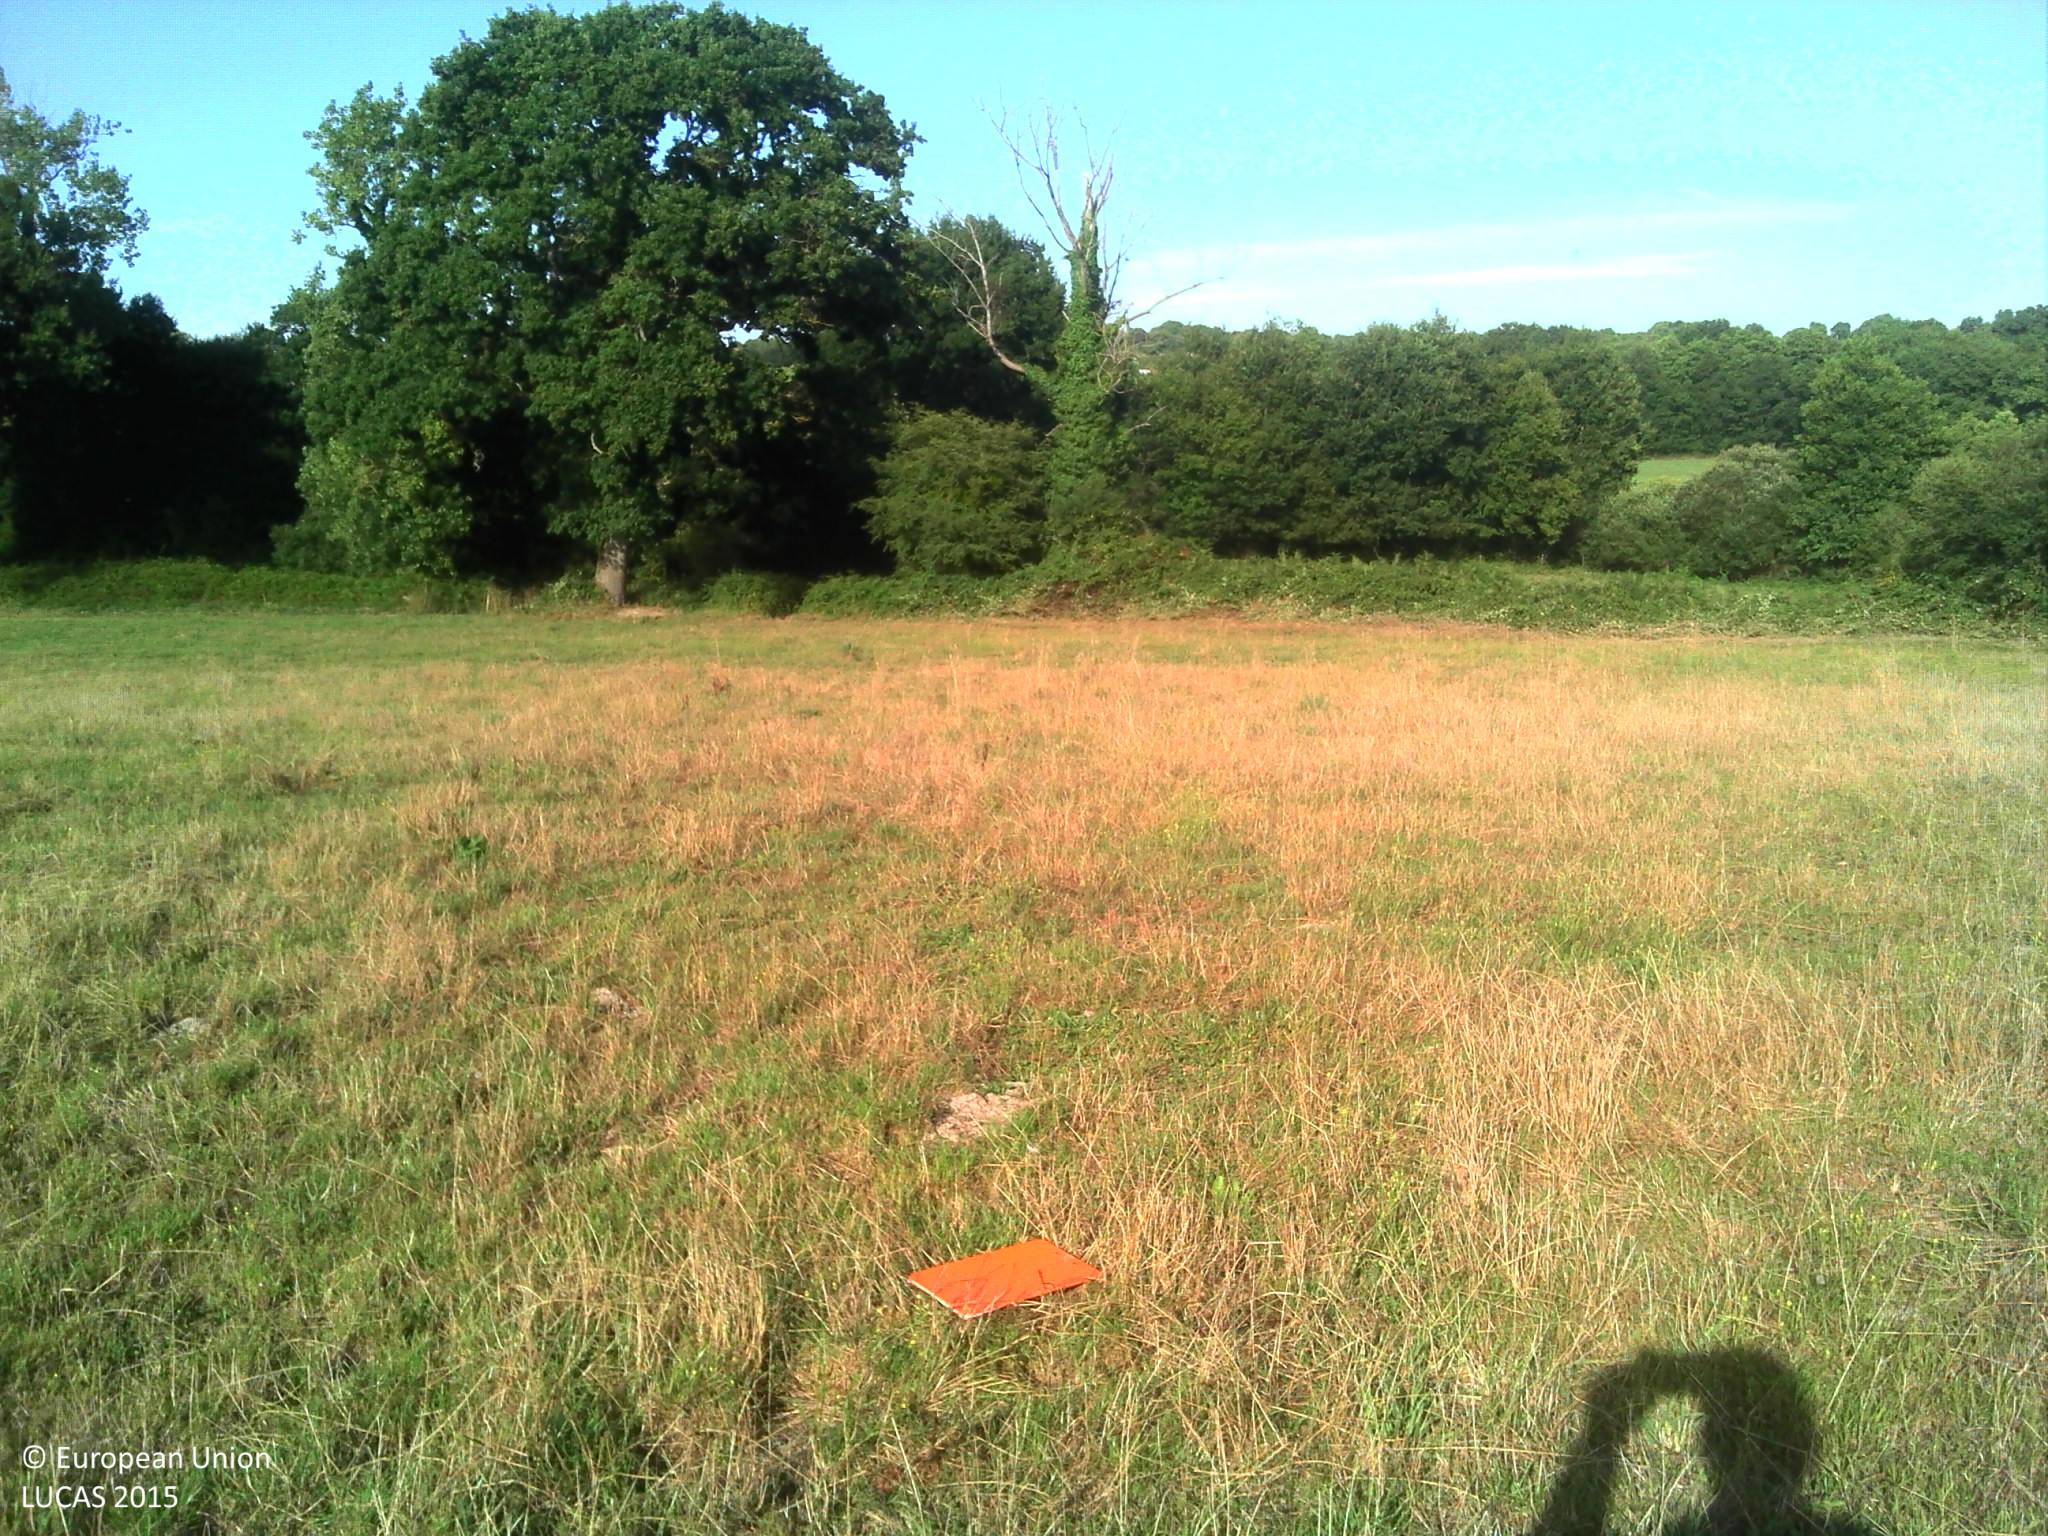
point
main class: Grassland
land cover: Grassland without tree/shrub cover
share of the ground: > 75 %
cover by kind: herbaceous plants 100 %
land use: Agriculture (excluding fallow land and kitchen gardens)
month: August
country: FR
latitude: 46.6515
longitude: -1.7097
